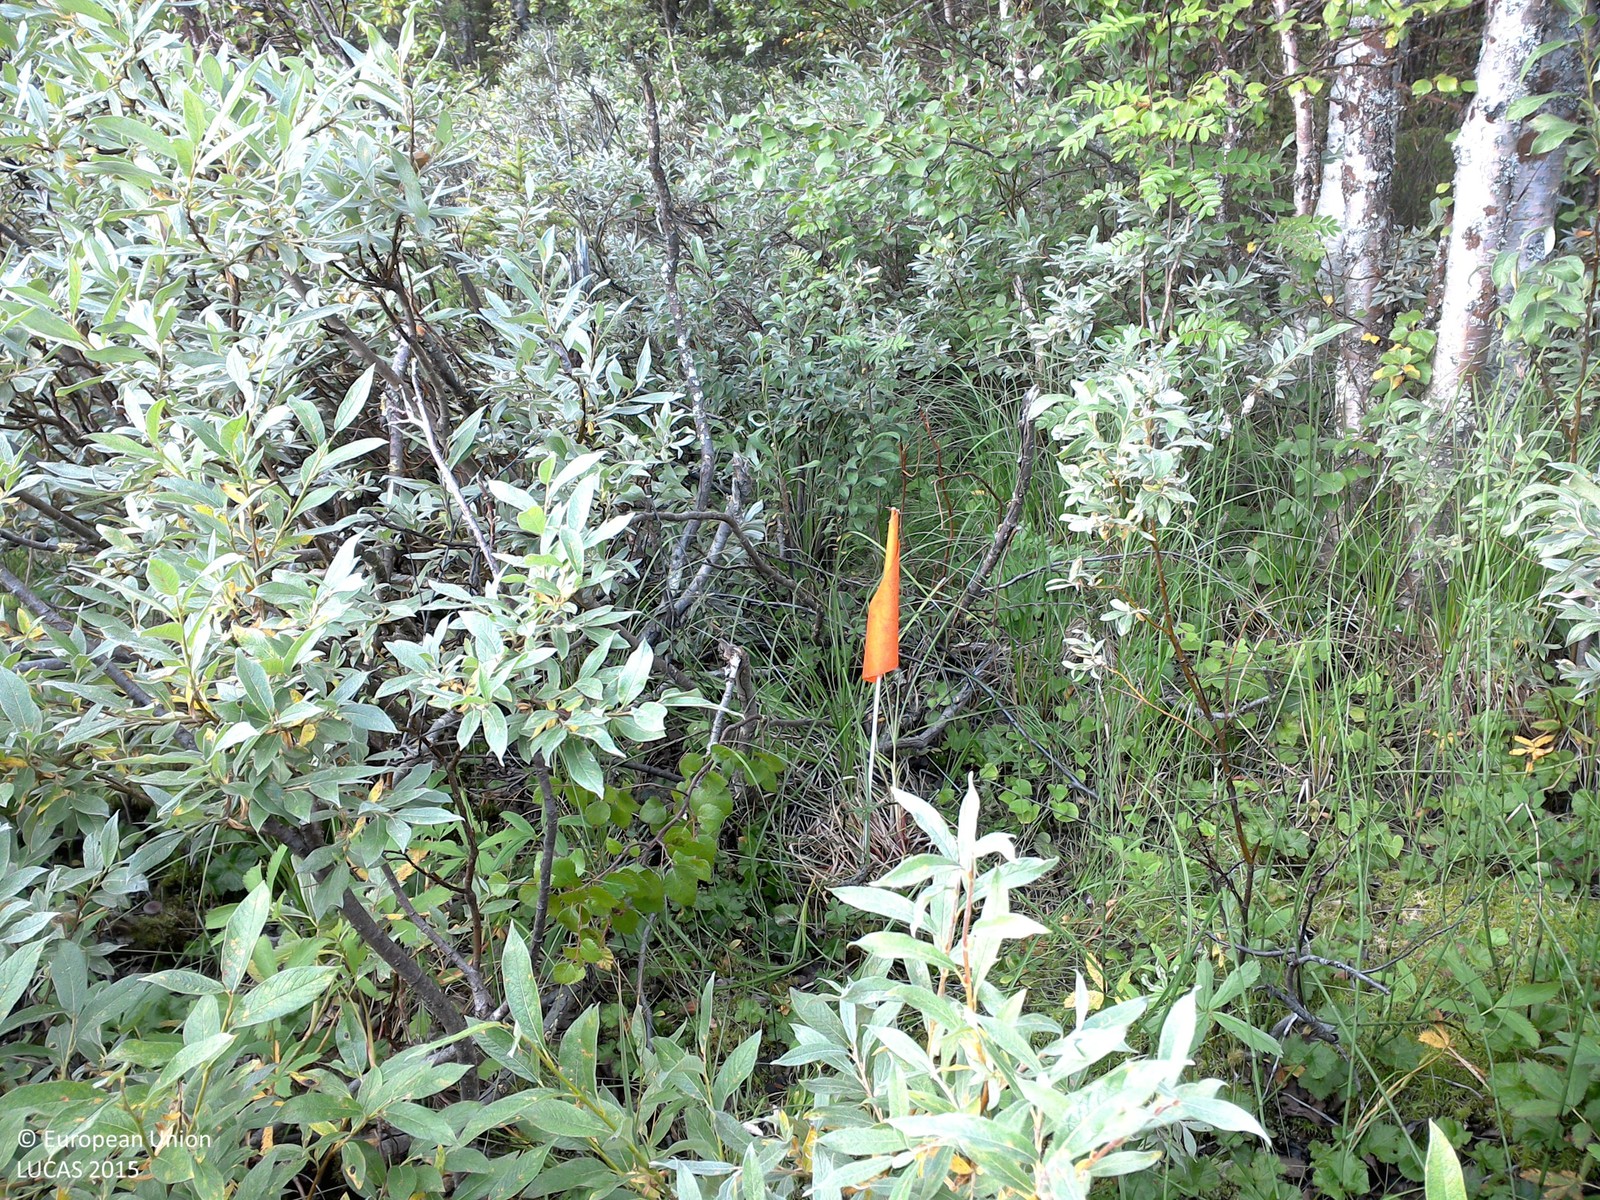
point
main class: Woodland
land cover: Broadleaved woodland
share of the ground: 50 - 75 %
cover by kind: broadleaved forest trees 55 %, shrubs 40 %, herbaceous plants 5 %
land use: Semi-natural and natural areas not in use
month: August
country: SE
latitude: 67.3837
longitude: 21.8144
